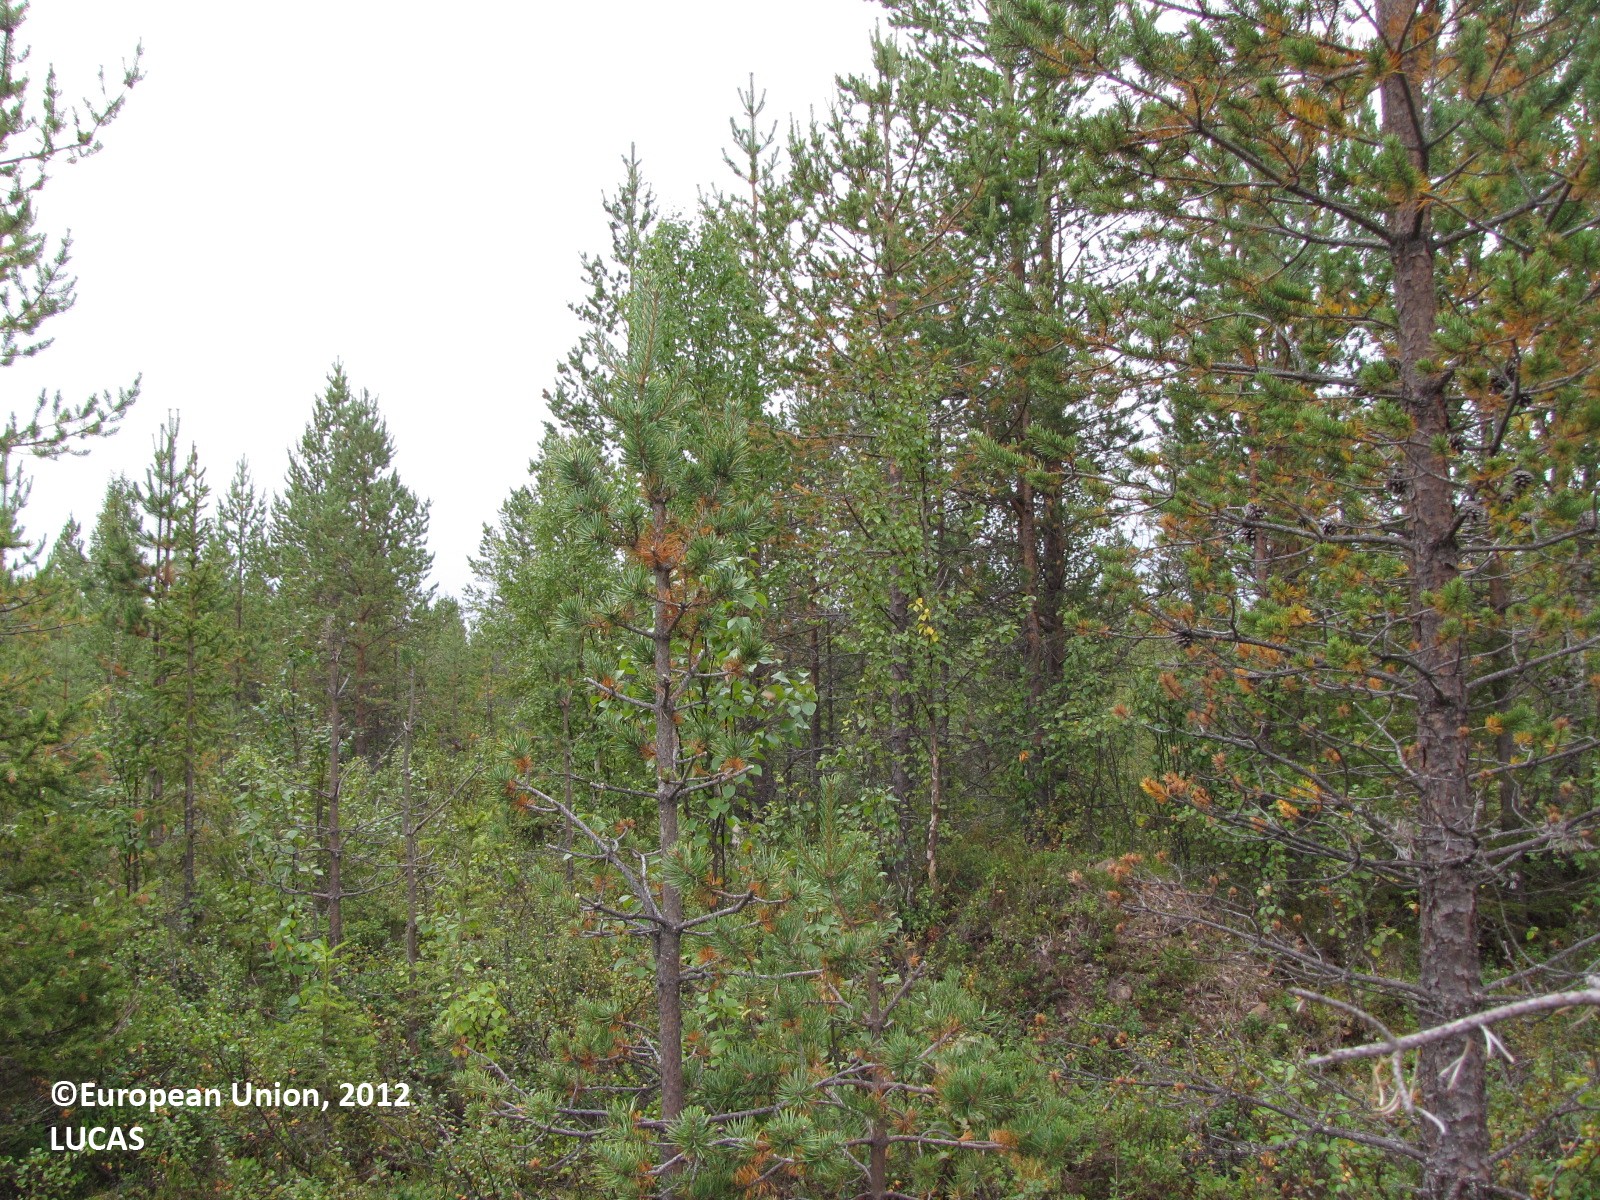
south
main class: Woodland
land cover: Other coniferous woodland
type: boreal forest
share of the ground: 25 - 50 %
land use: Forestry
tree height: > 5 m
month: August
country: FI
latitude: 67.1205
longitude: 25.1917
